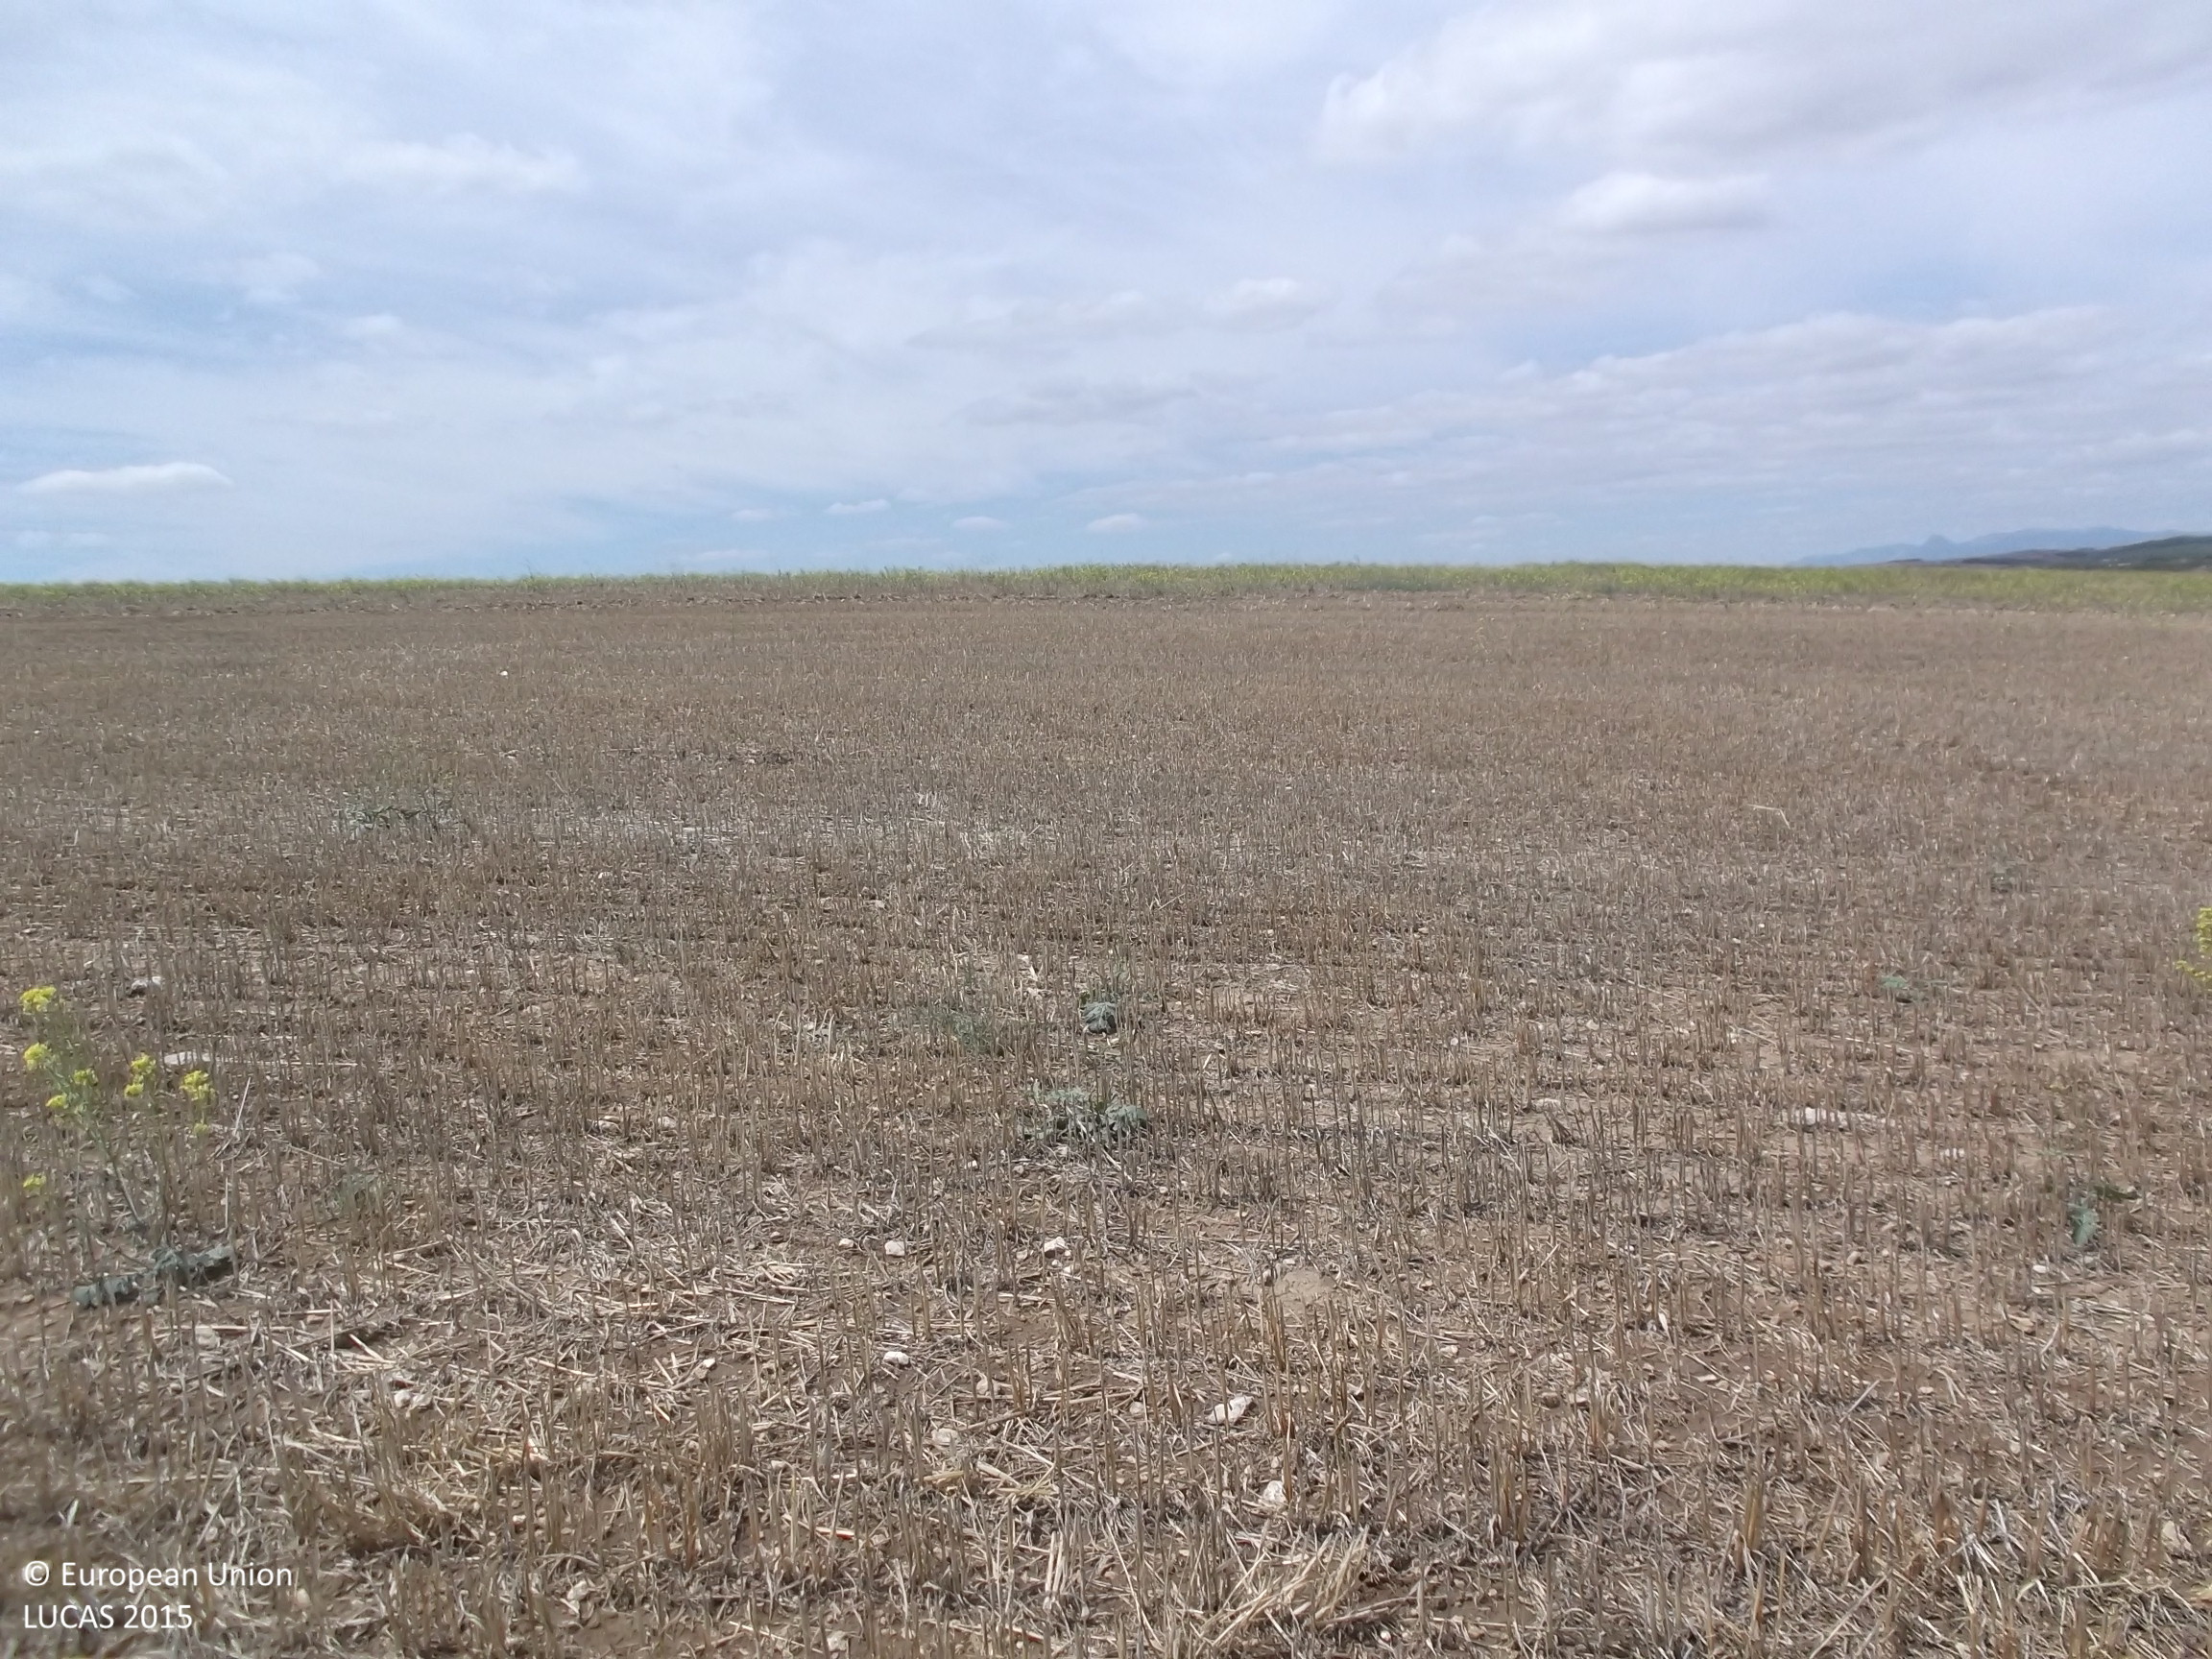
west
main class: Cropland
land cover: Oats
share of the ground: < 10 %
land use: Agriculture (excluding fallow land and kitchen gardens)
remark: Harvested field
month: August
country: ES
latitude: 42.4678
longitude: -2.1428
